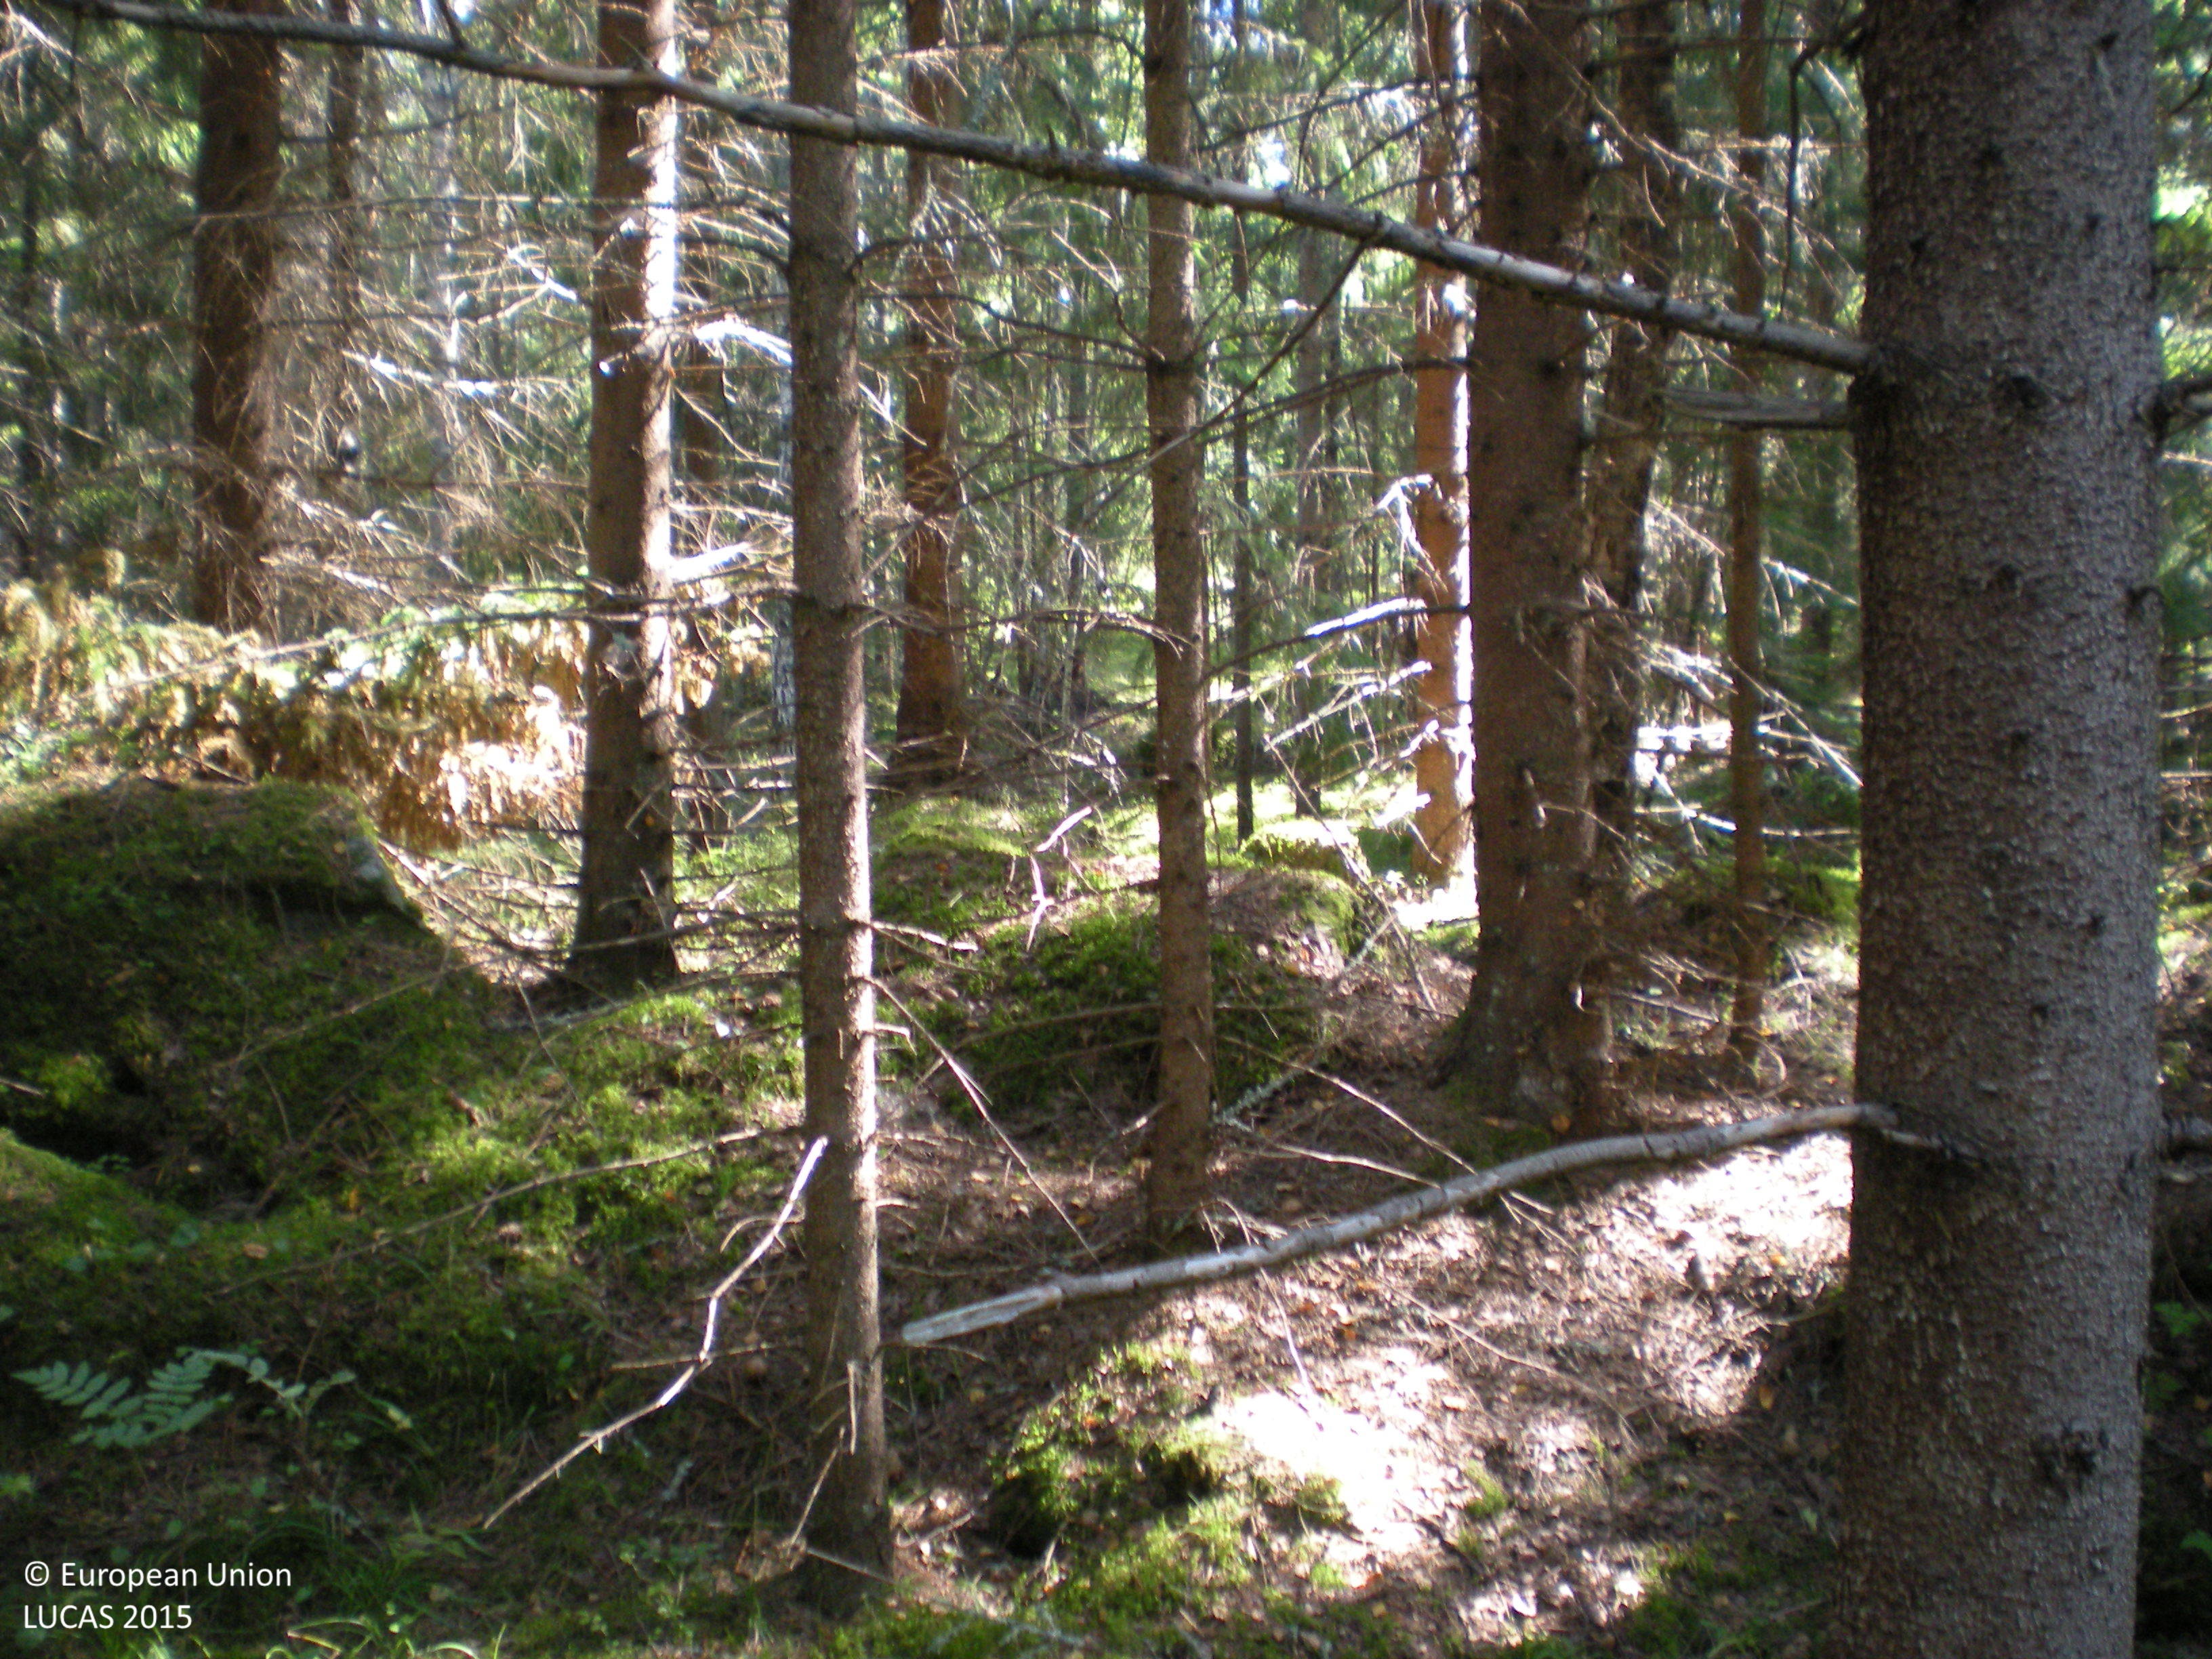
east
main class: Woodland
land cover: Spruce dominated coniferous woodland
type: boreal forest
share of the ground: > 75 %
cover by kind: coniferous forest trees 80 %, lichens and mosses 10 %, broadleaved forest trees 5 %, shrubs 5 %
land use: Forestry
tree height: > 5 m
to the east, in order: Spruce dominated coniferous woodland; Spruce dominated mixed woodland; Grass margins; Spruce dominated mixed woodland
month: August
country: SE
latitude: 60.6246
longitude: 17.6483
